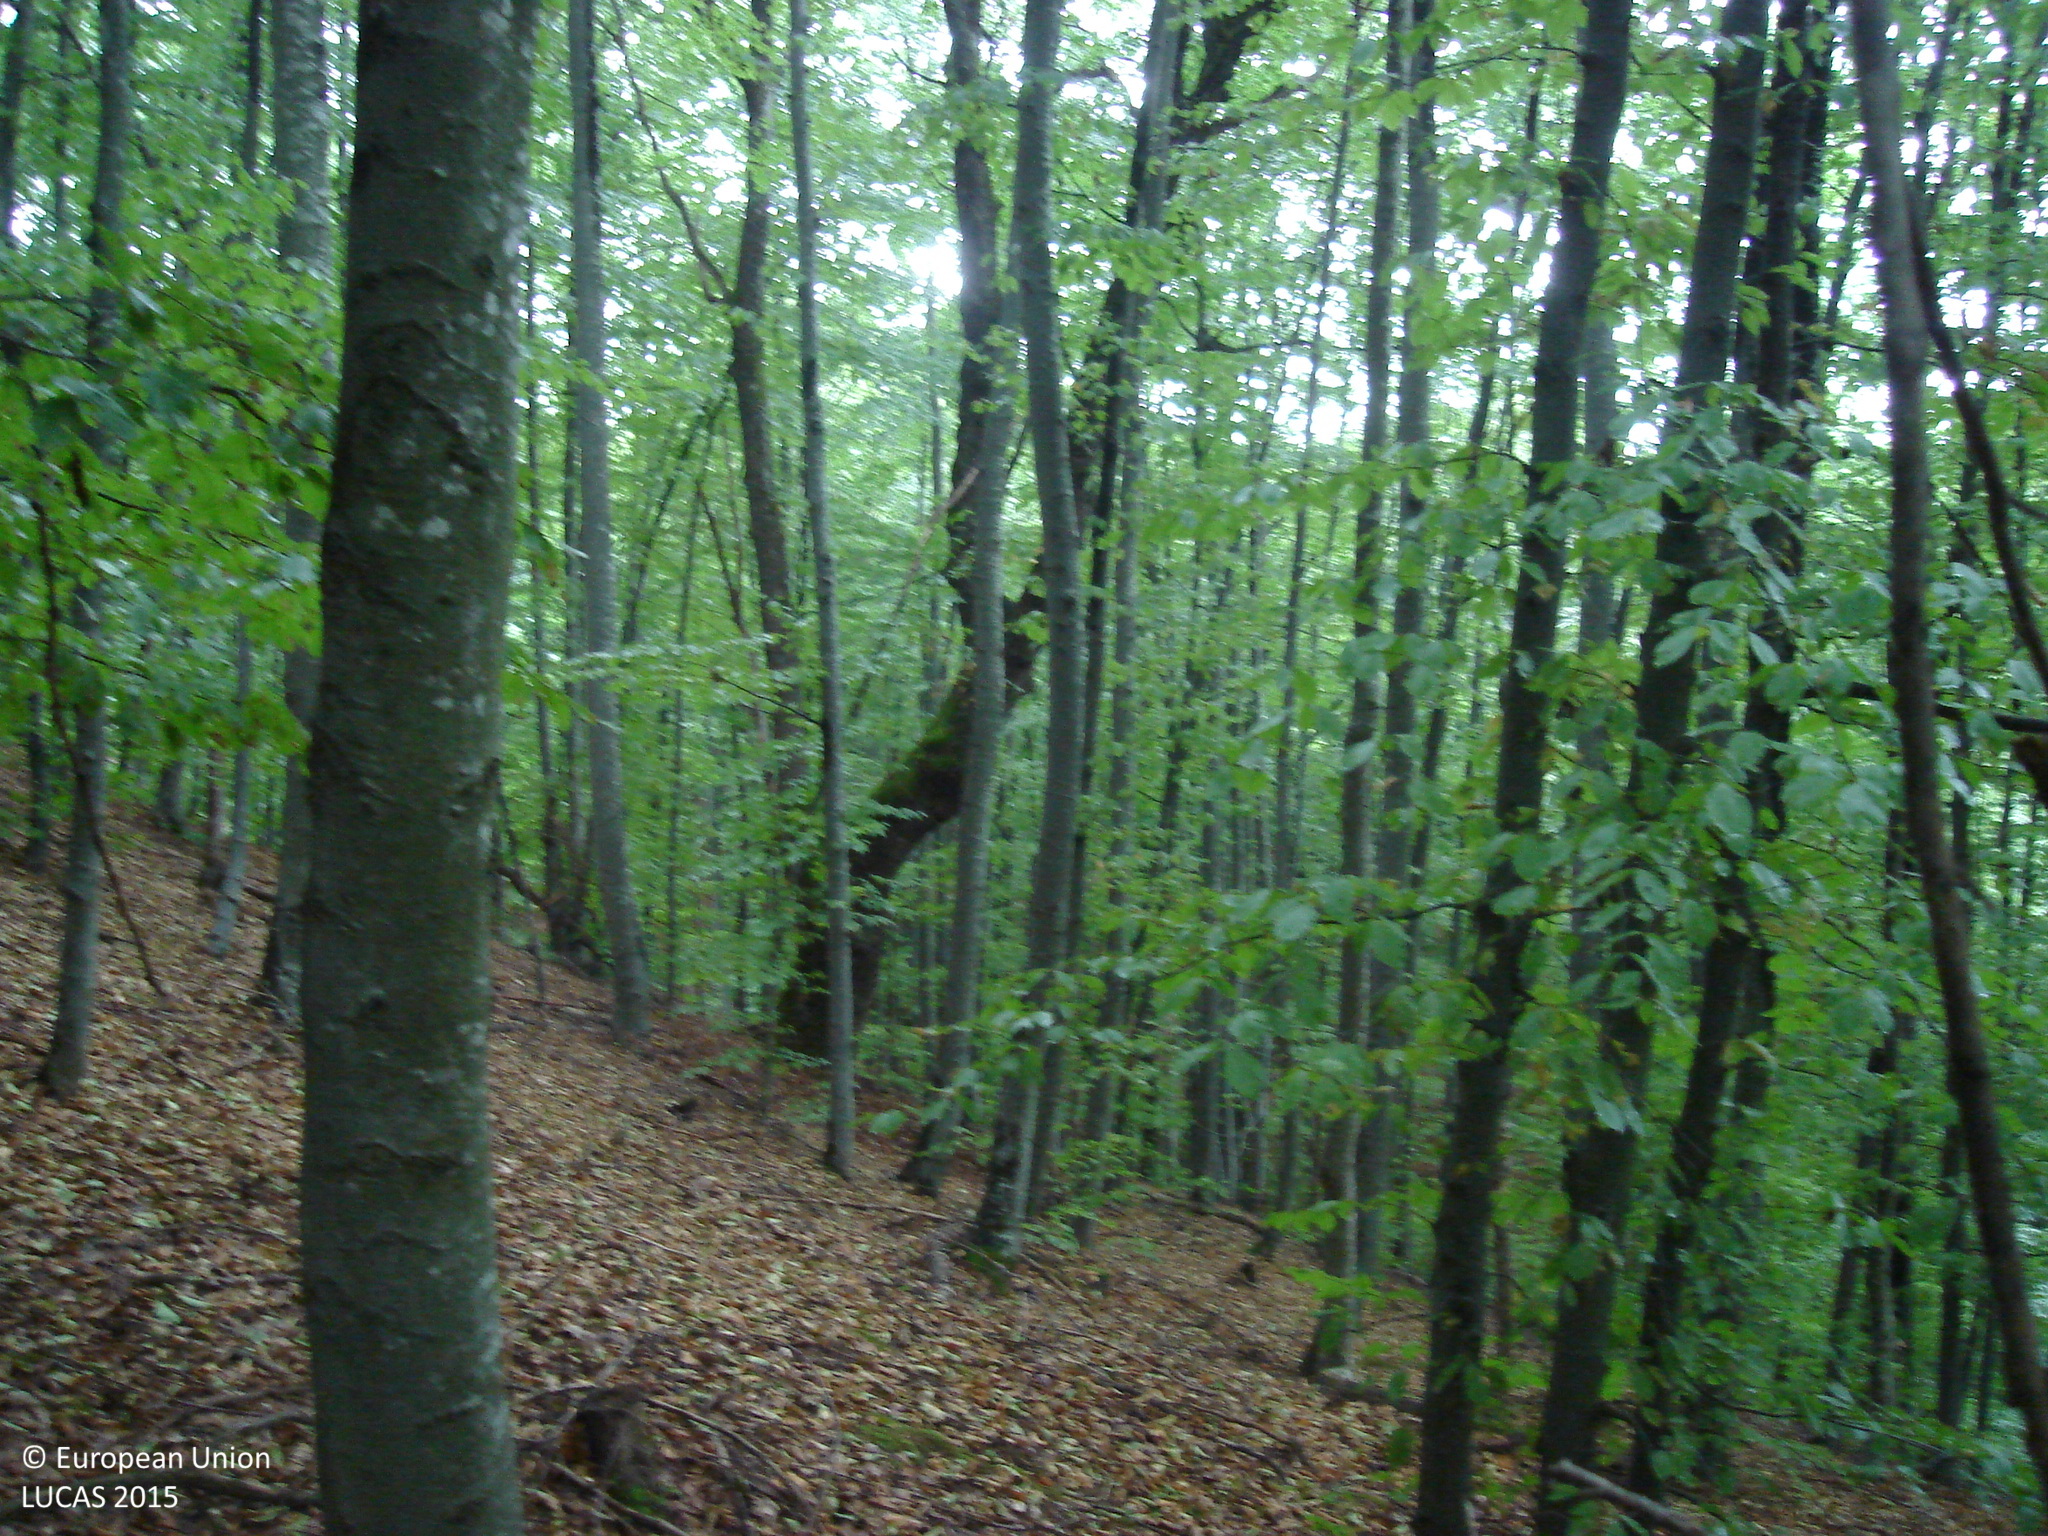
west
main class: Woodland
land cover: Broadleaved woodland
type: beech forest
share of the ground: > 75 %
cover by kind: broadleaved forest trees 80 %, consolidated bare surface 20 %
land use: Forestry
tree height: > 5 m
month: September
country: BG
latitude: 42.8673
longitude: 23.9881
